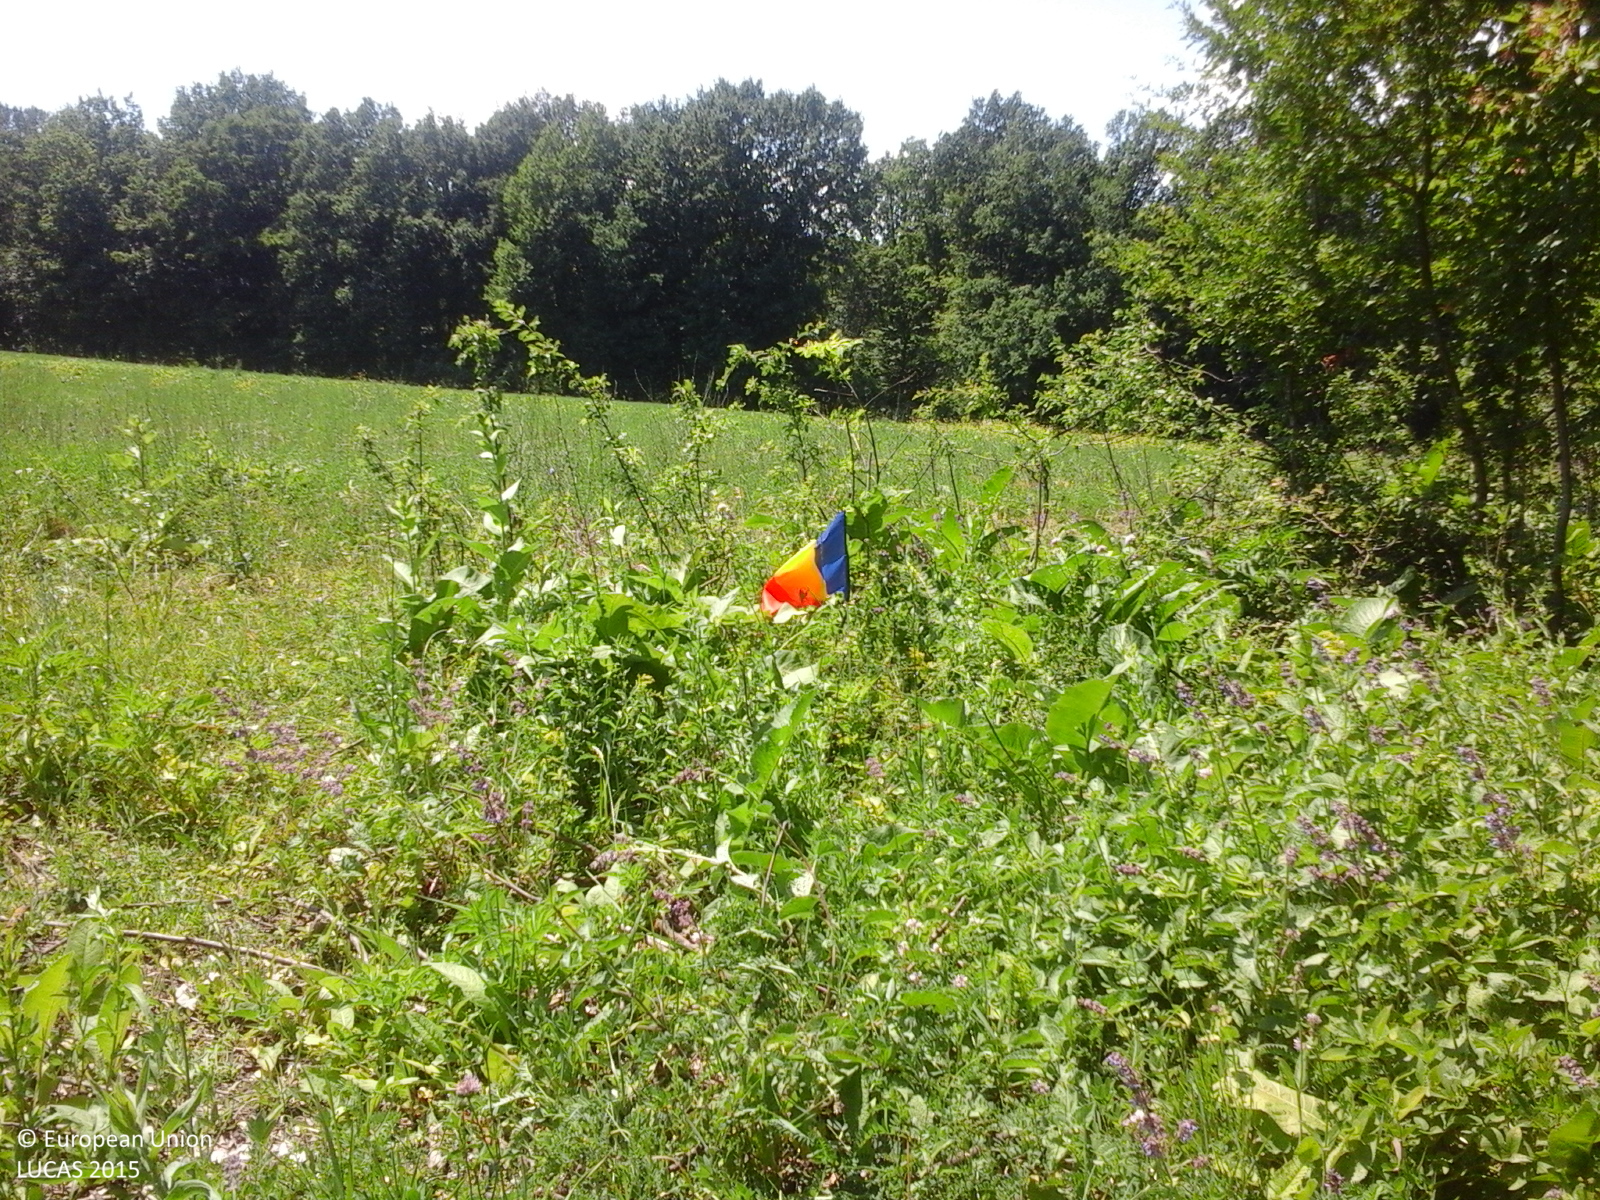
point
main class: Woodland
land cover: Broadleaved woodland
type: mesophytic deciduous forest
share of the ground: > 75 %
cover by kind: broadleaved forest trees 100 %
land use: Forestry
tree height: > 5 m
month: June
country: RO
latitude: 46.9941
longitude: 27.2678
